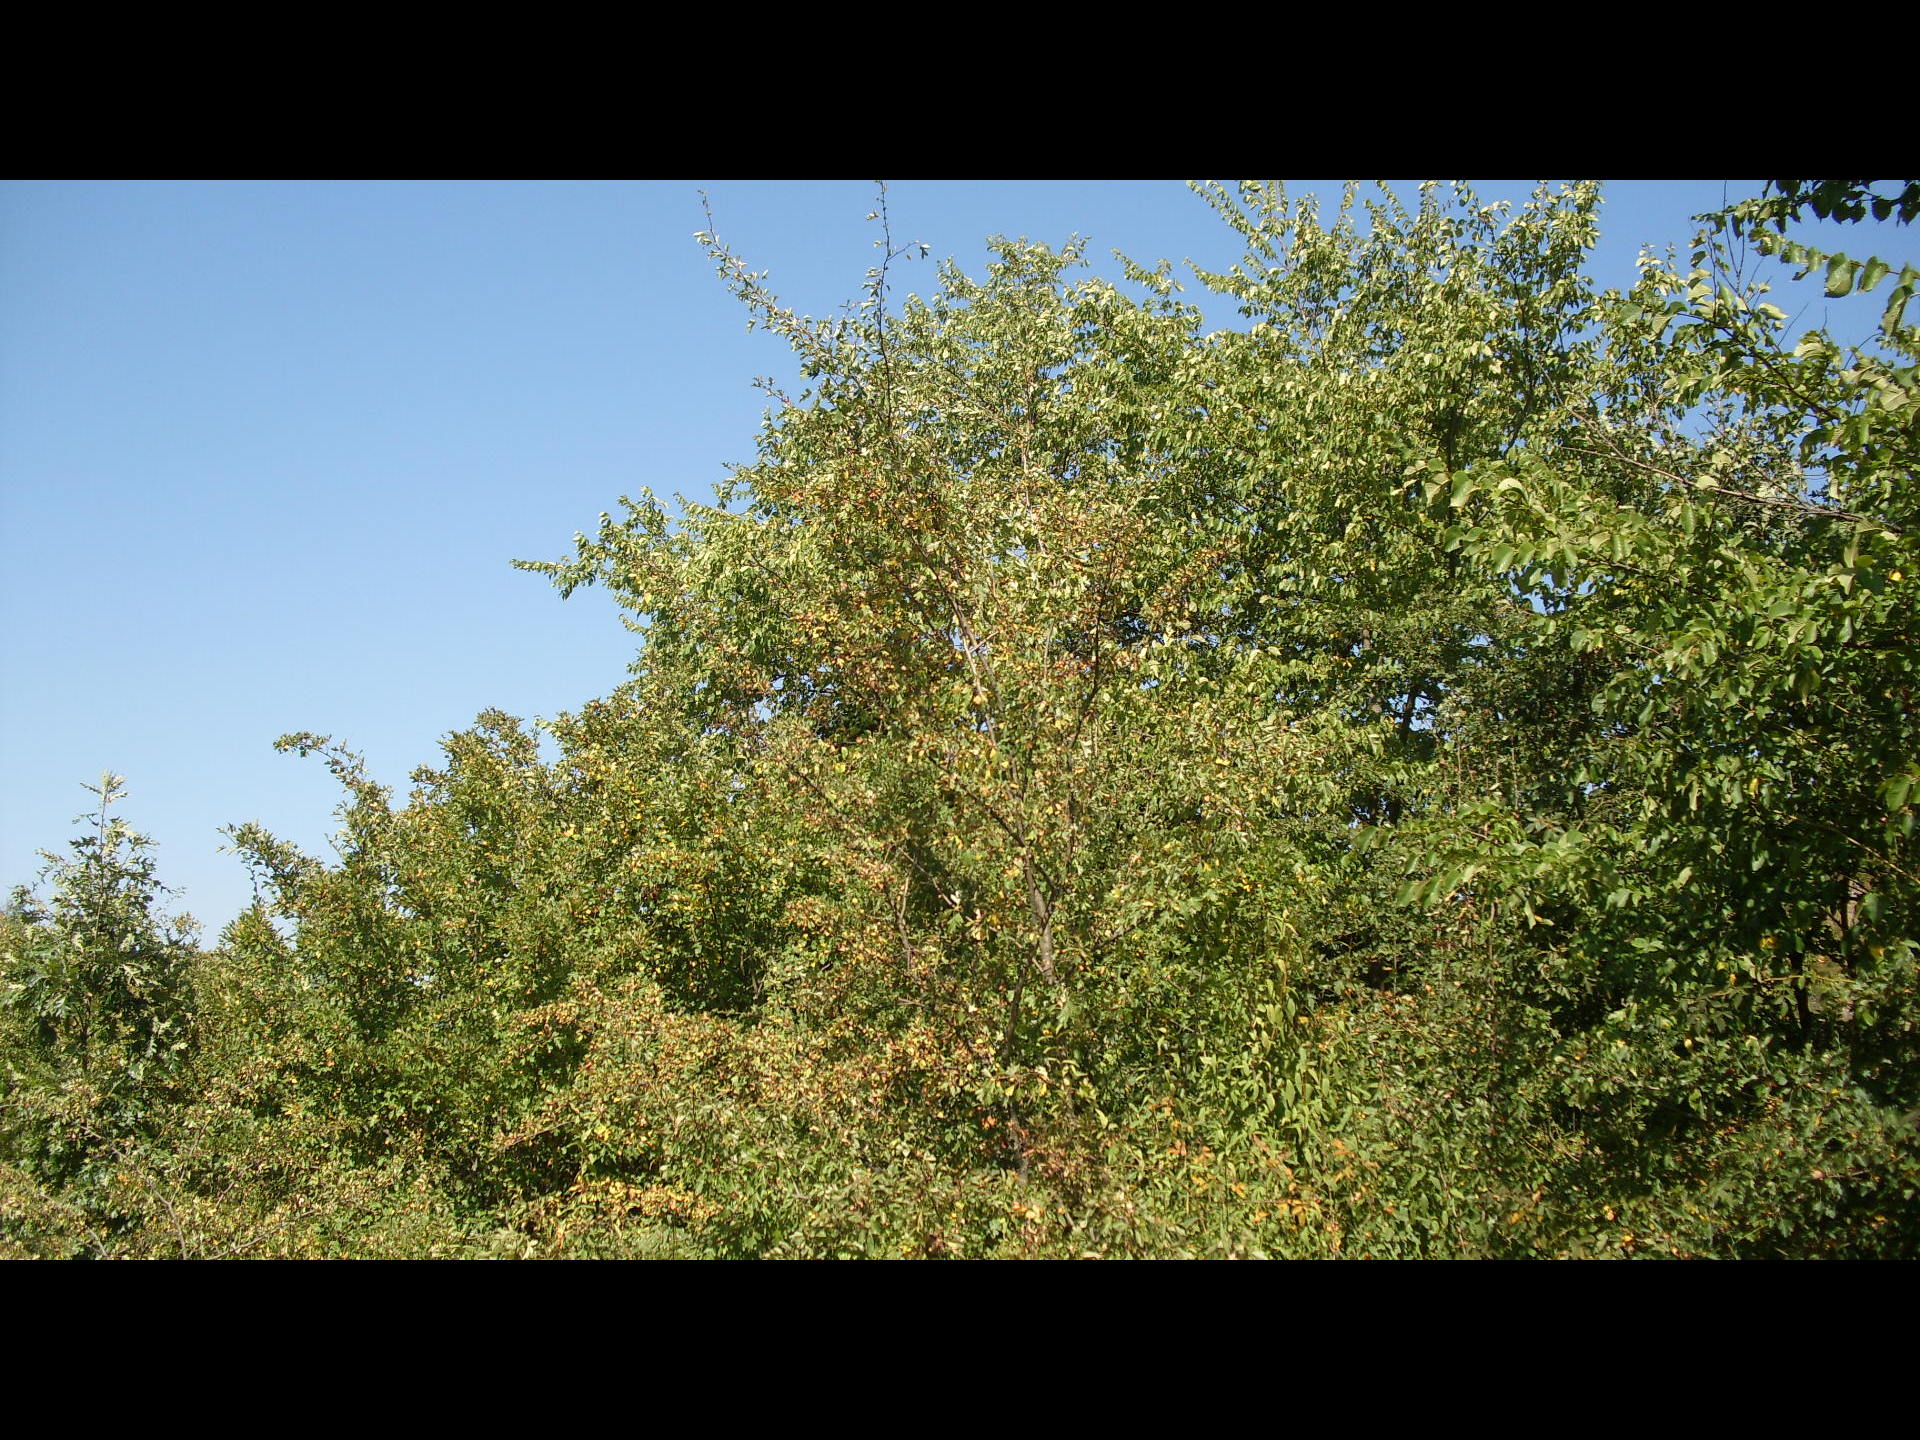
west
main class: Woodland
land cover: Broadleaved woodland
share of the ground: > 75 %
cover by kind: broadleaved forest trees 60 %, shrubs 40 %
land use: Forestry
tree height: < 5 m
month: August
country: BG
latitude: 43.2456
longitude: 23.3535
